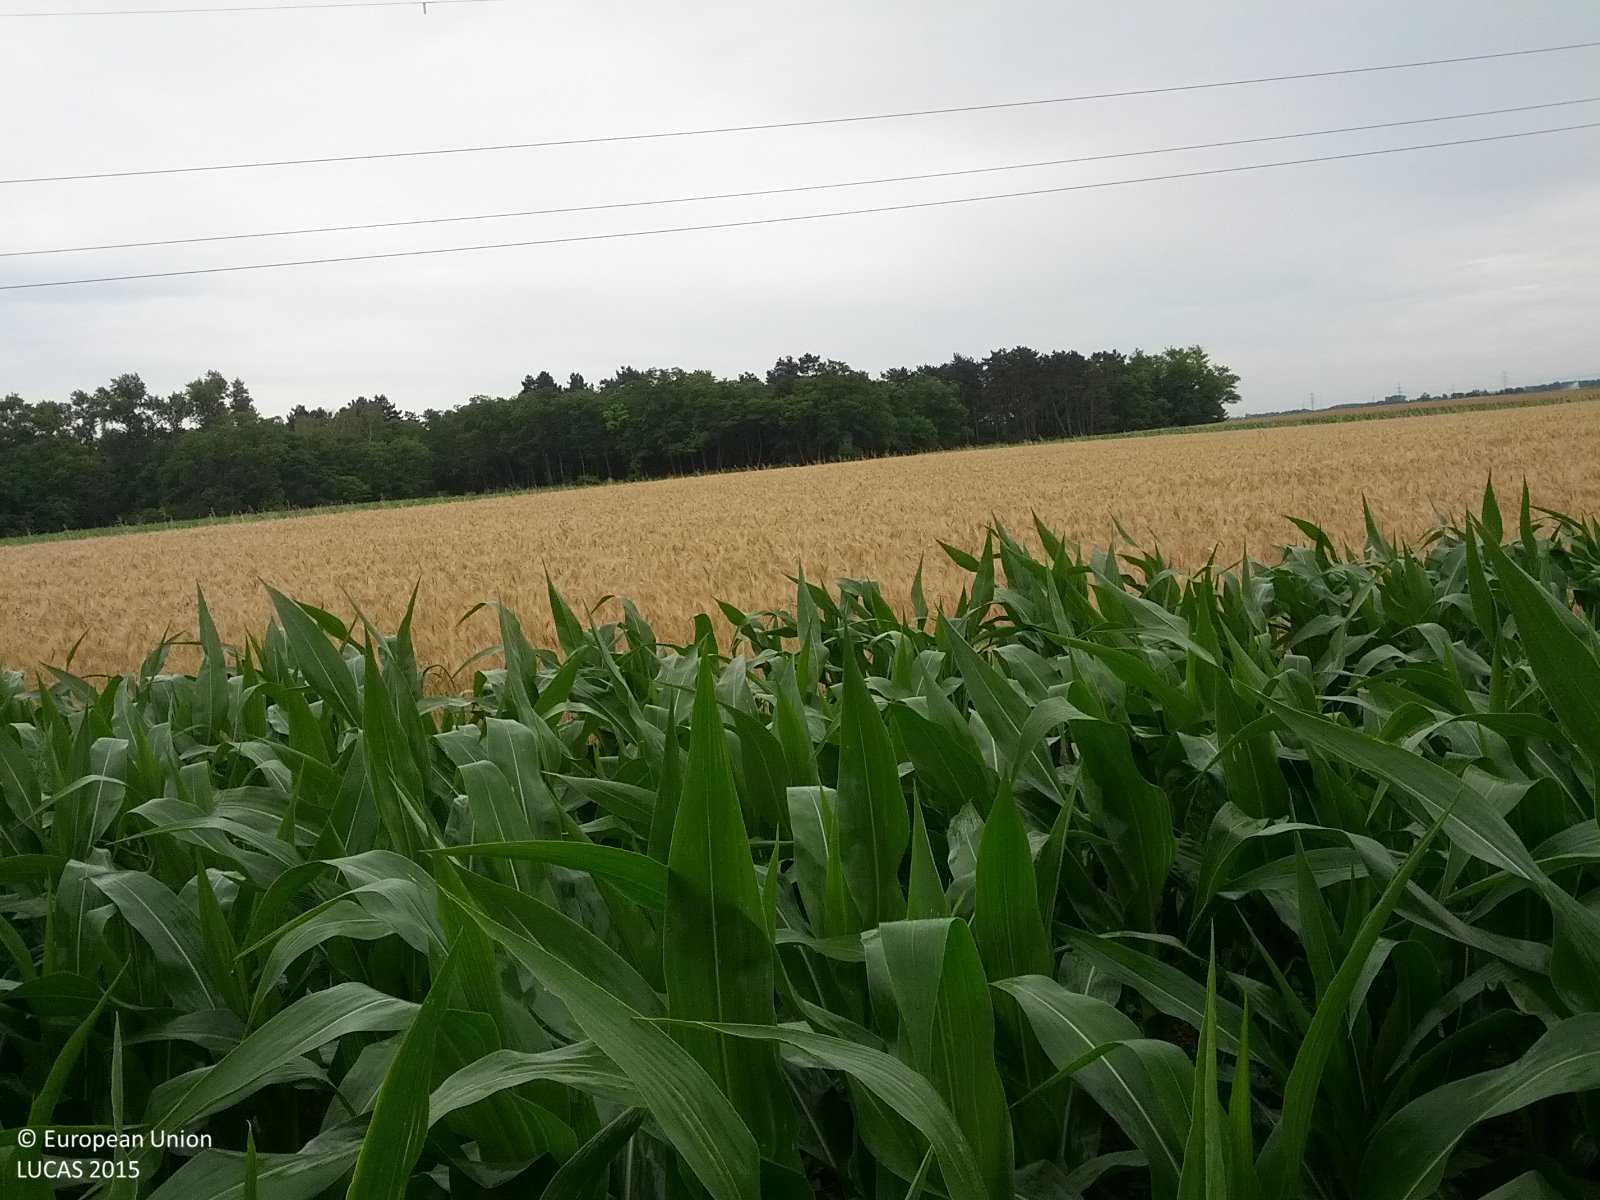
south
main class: Cropland
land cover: Maize
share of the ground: > 75 %
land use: Agriculture (excluding fallow land and kitchen gardens)
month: June
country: AT
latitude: 48.3341
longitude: 16.5755
